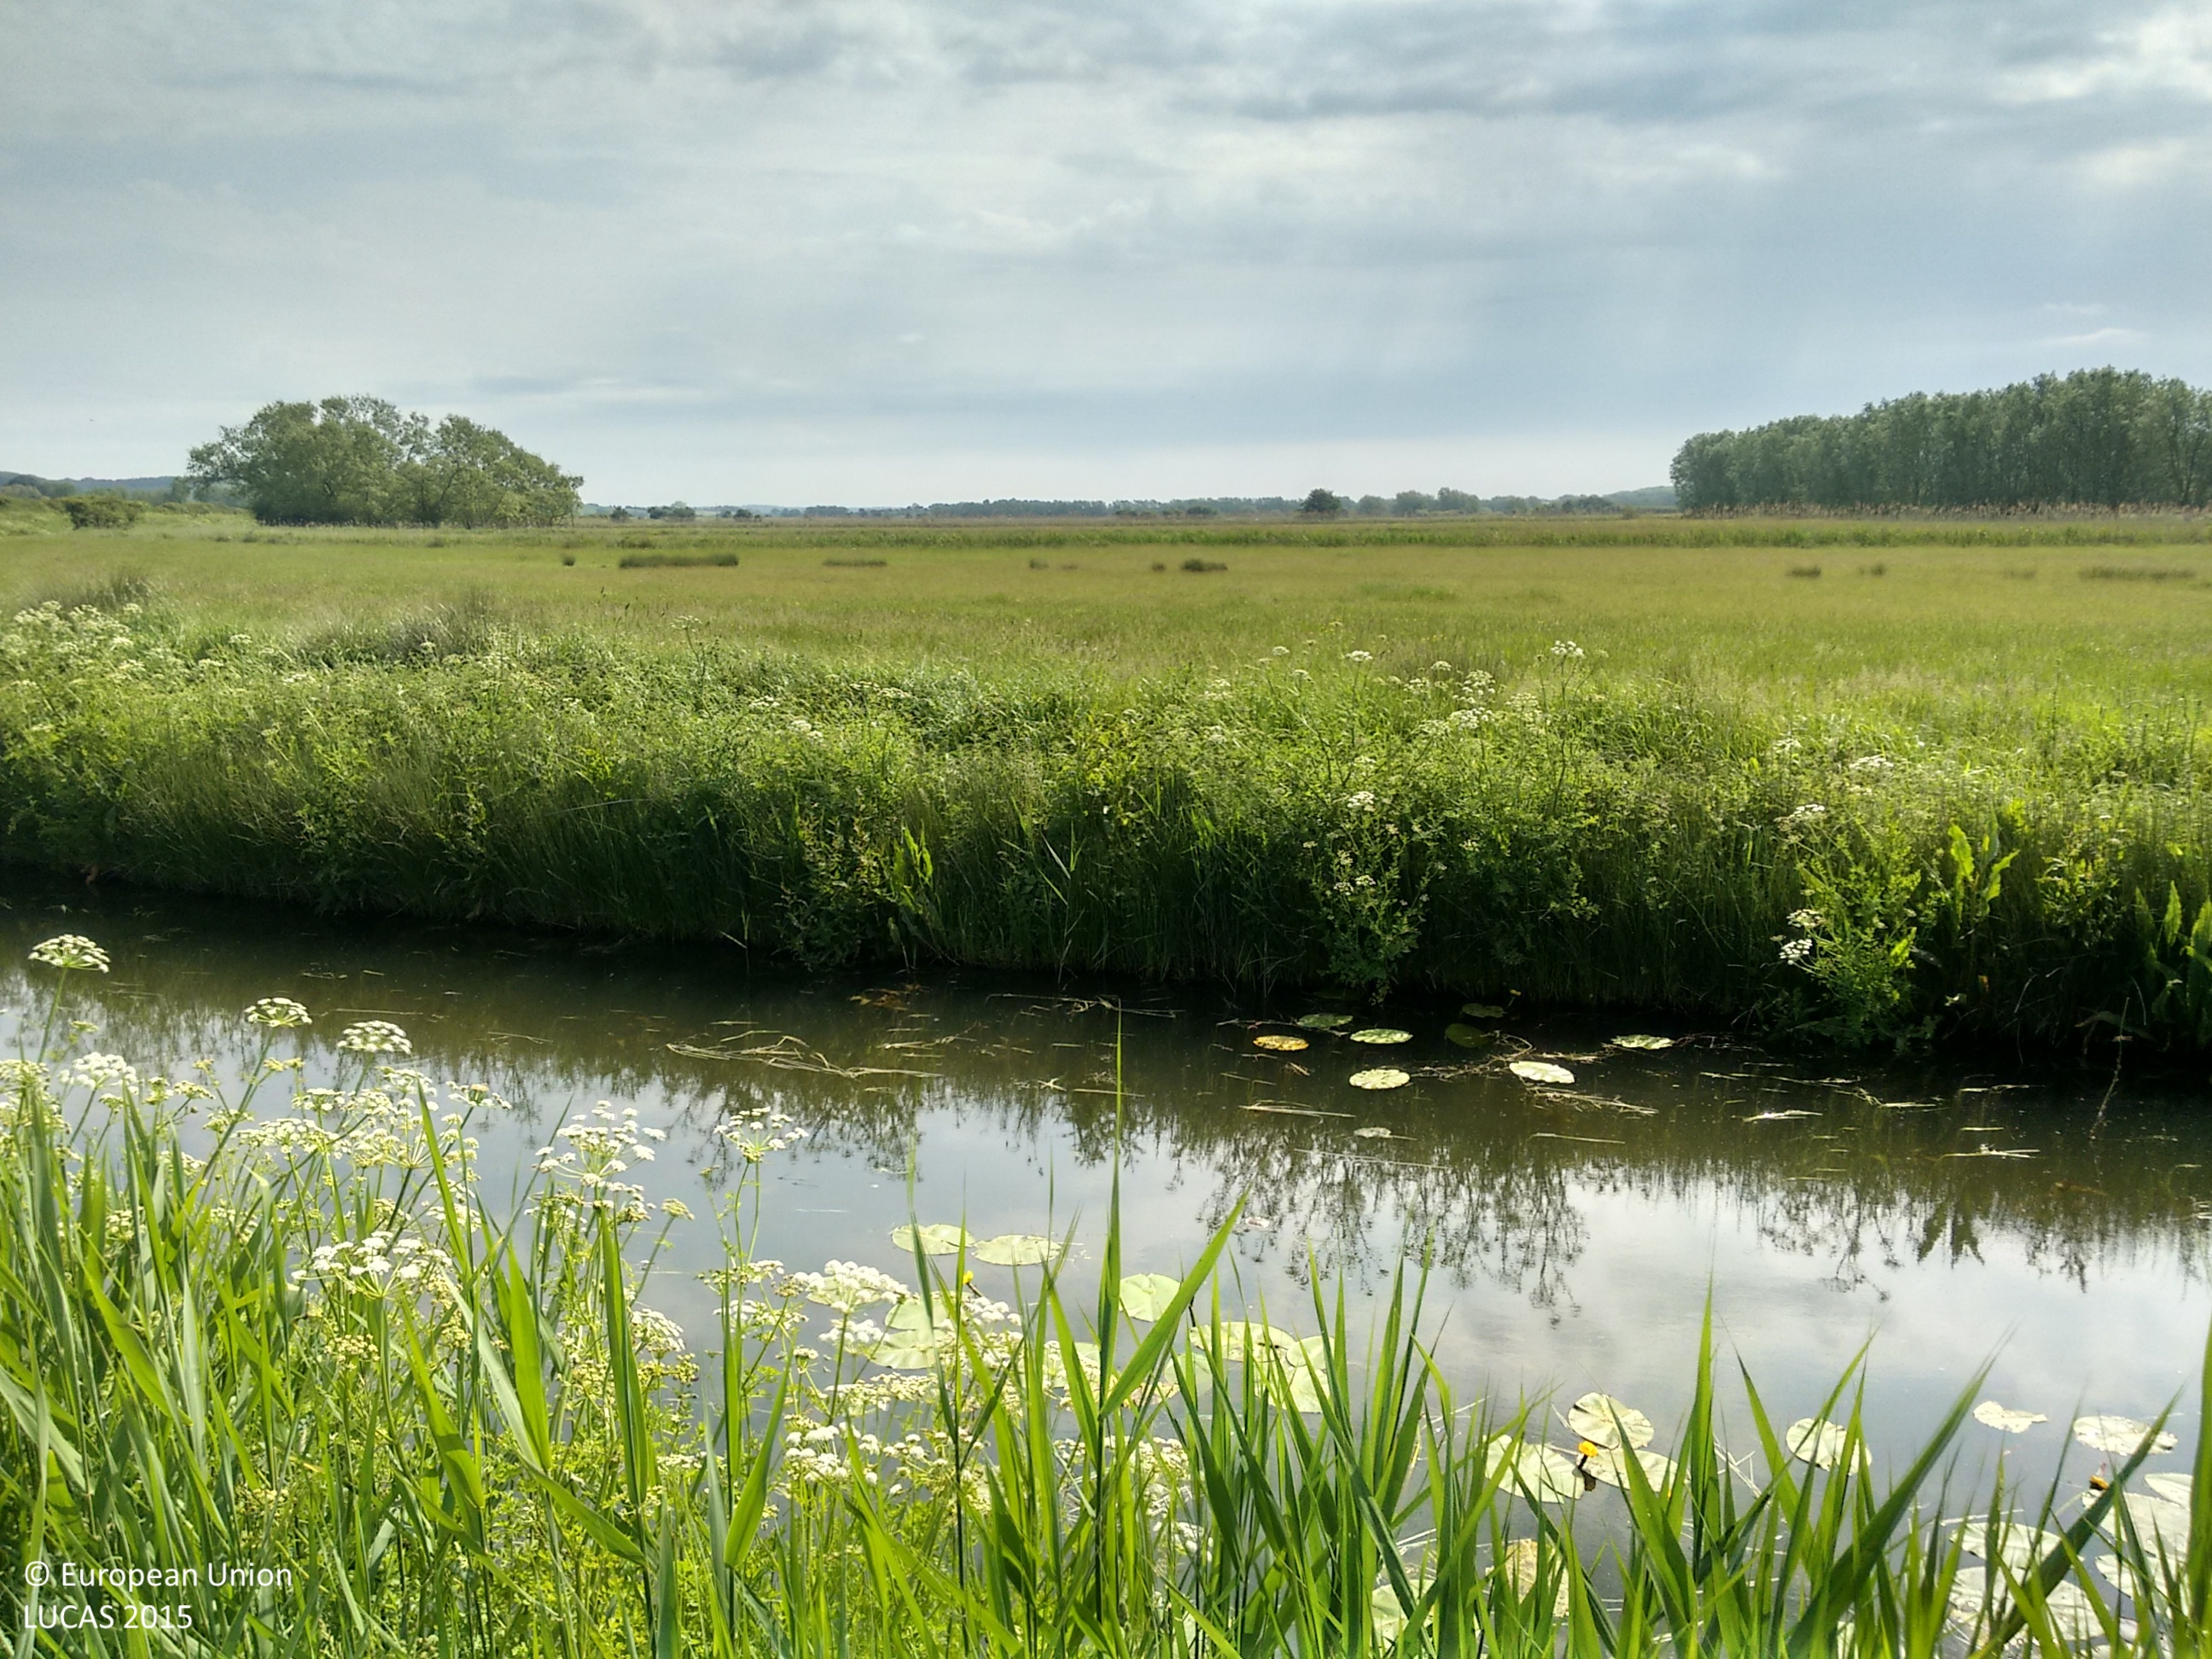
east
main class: Grassland
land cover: Grassland without tree/shrub cover
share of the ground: > 75 %
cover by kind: herbaceous plants 100 %
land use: Agriculture (excluding fallow land and kitchen gardens)
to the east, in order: Grassland without tree/shrub cover; Inland fresh running water; Grassland without tree/shrub cover; Inland fresh running water; Grassland without tree/shrub cover; Inland fresh running water; Grassland without tree/shrub cover
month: June
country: GB
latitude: 51.0336
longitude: 0.6906
